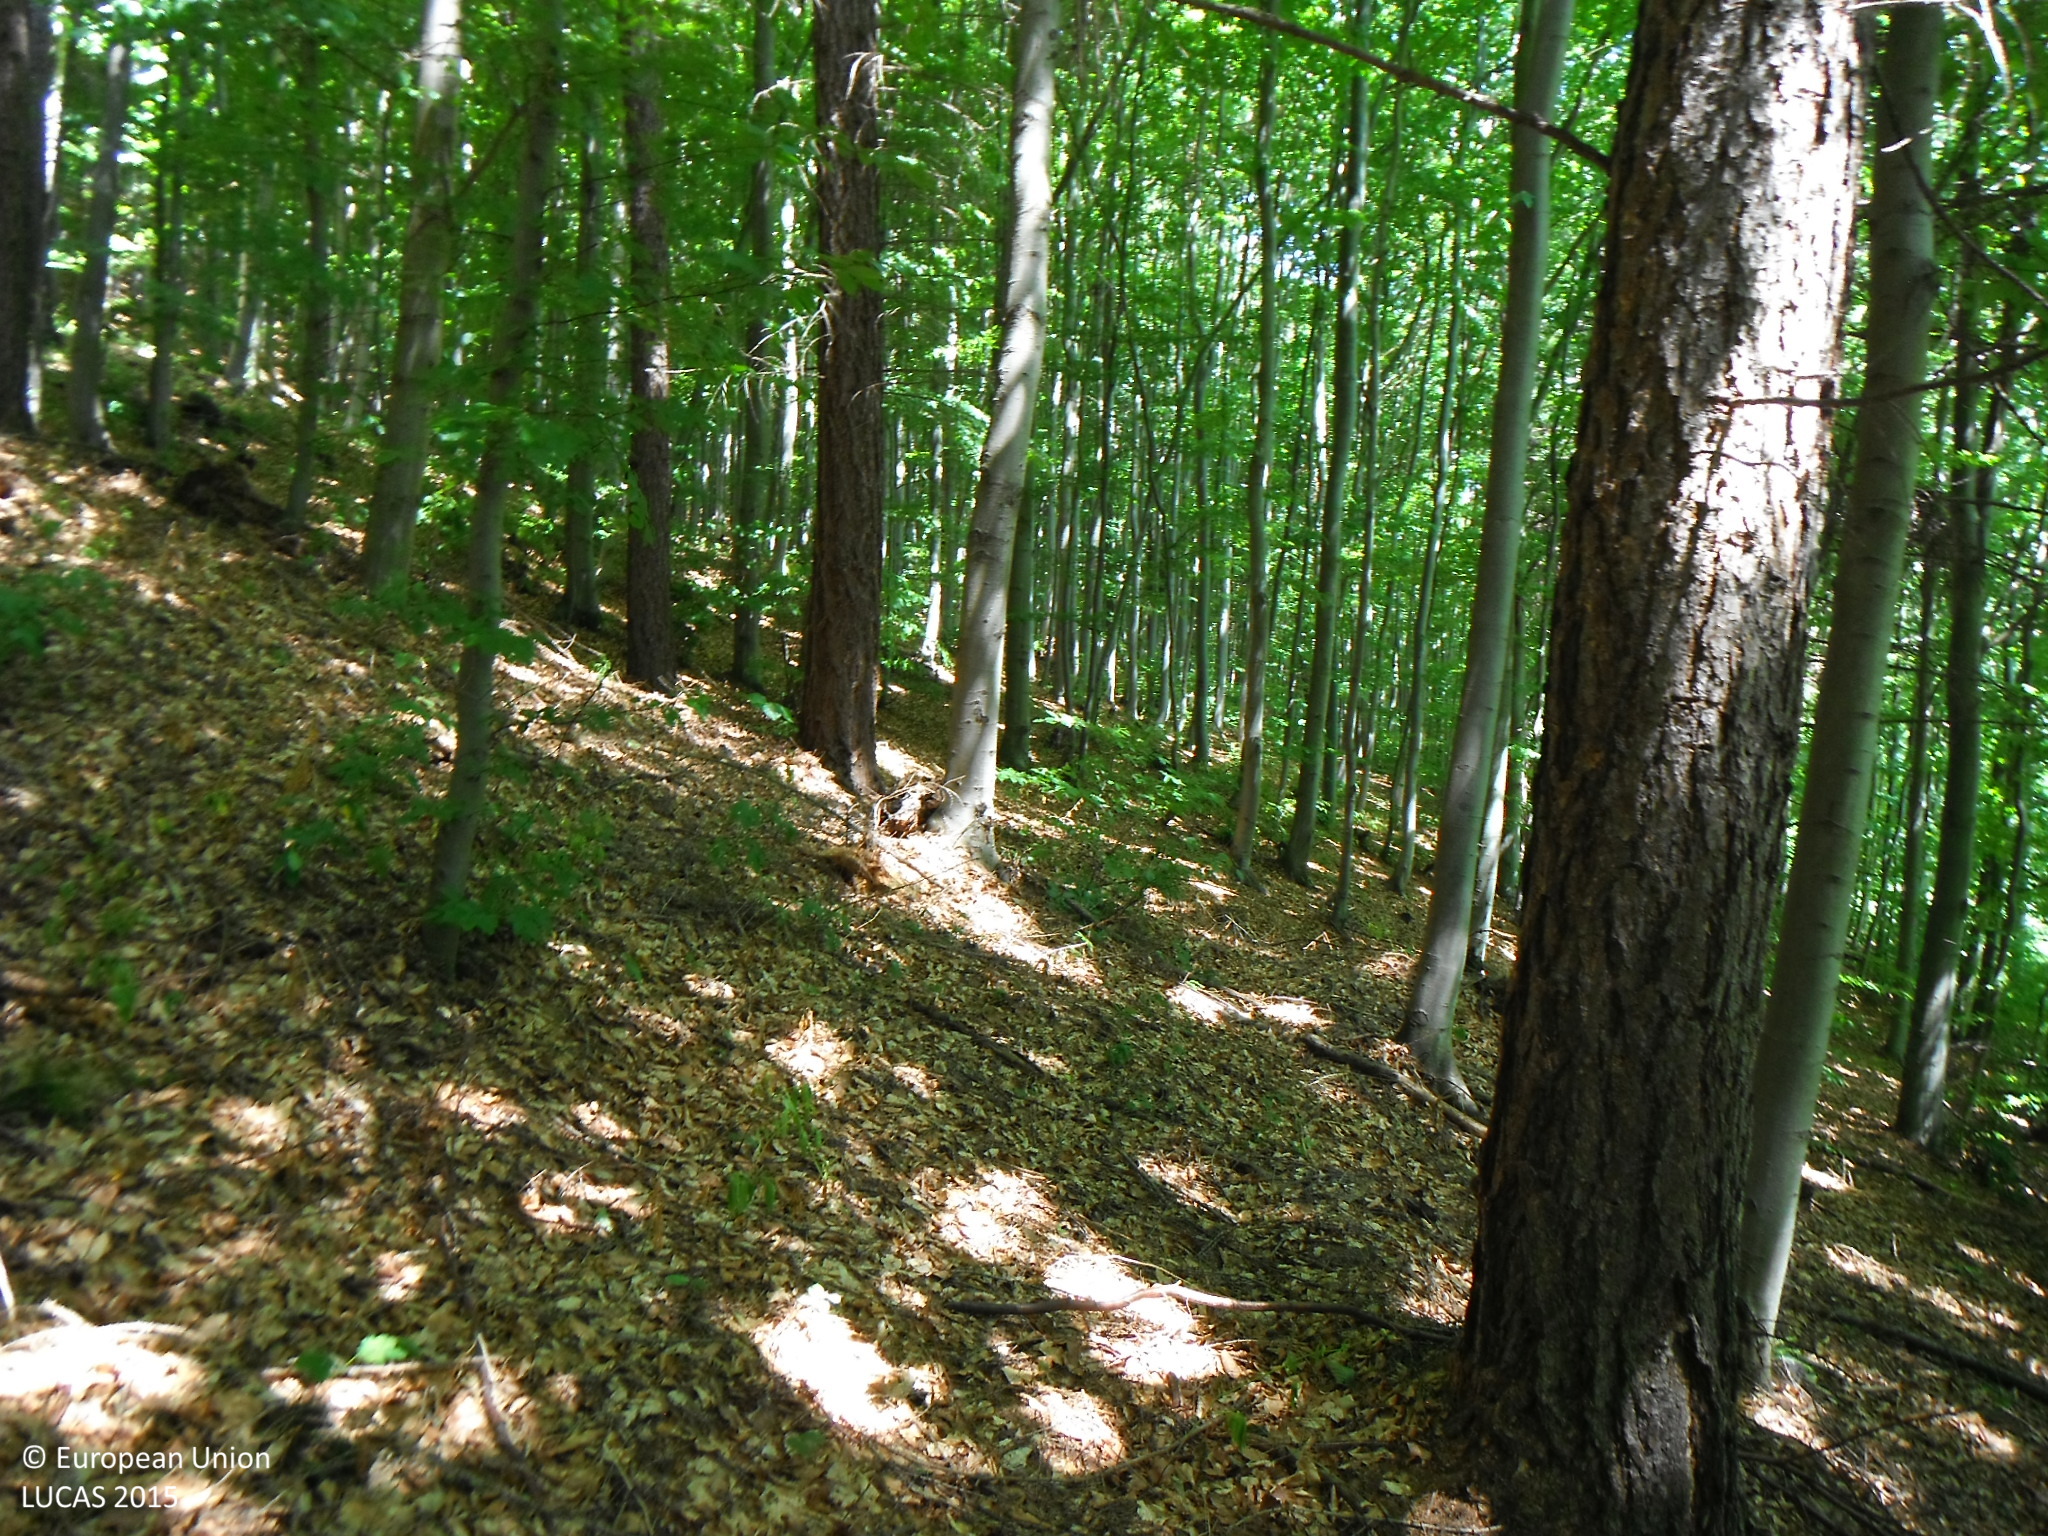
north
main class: Woodland
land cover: Spruce dominated coniferous woodland
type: hemiboreal forest and nemoral coniferous forest and mixed broadleaved-coniferous forest
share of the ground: > 75 %
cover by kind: coniferous forest trees 90 %, broadleaved forest trees 10 %
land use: Forestry
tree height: > 5 m
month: July
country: SK
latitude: 49.2161
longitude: 20.9838
